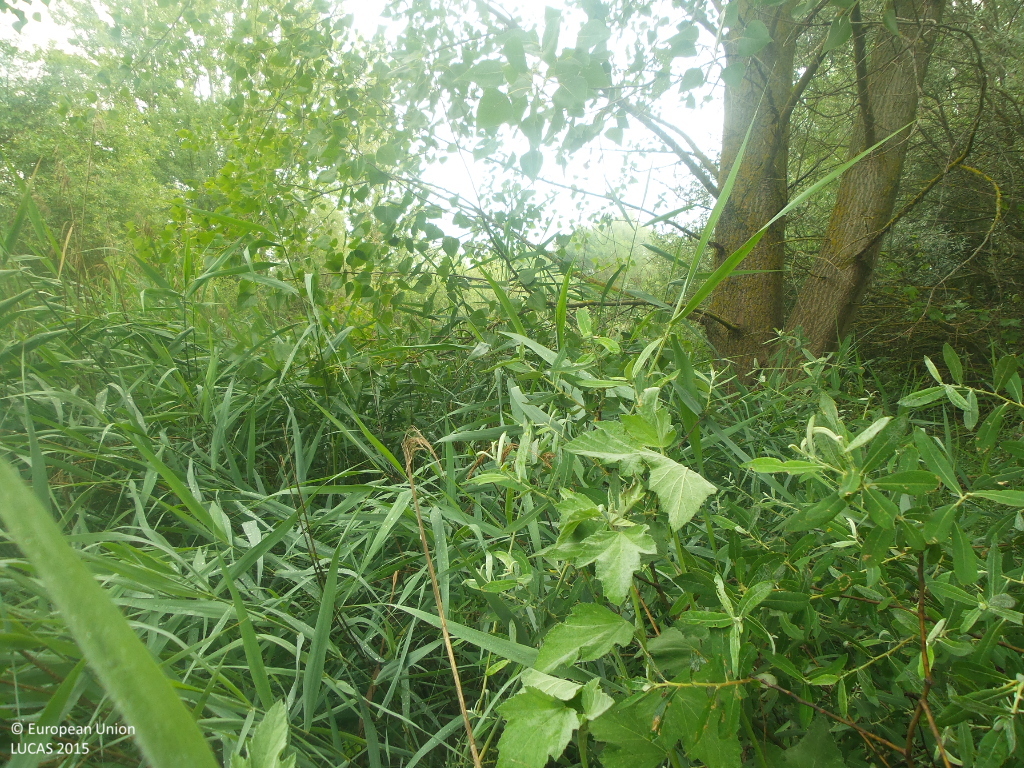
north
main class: Woodland
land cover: Broadleaved woodland
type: floodplain forest
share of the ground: > 75 %
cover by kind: broadleaved forest trees 80 %, shrubs 10 %, herbaceous plants 10 %
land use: Semi-natural and natural areas not in use
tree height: > 5 m
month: June
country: ES
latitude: 41.4978
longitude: -2.7482
